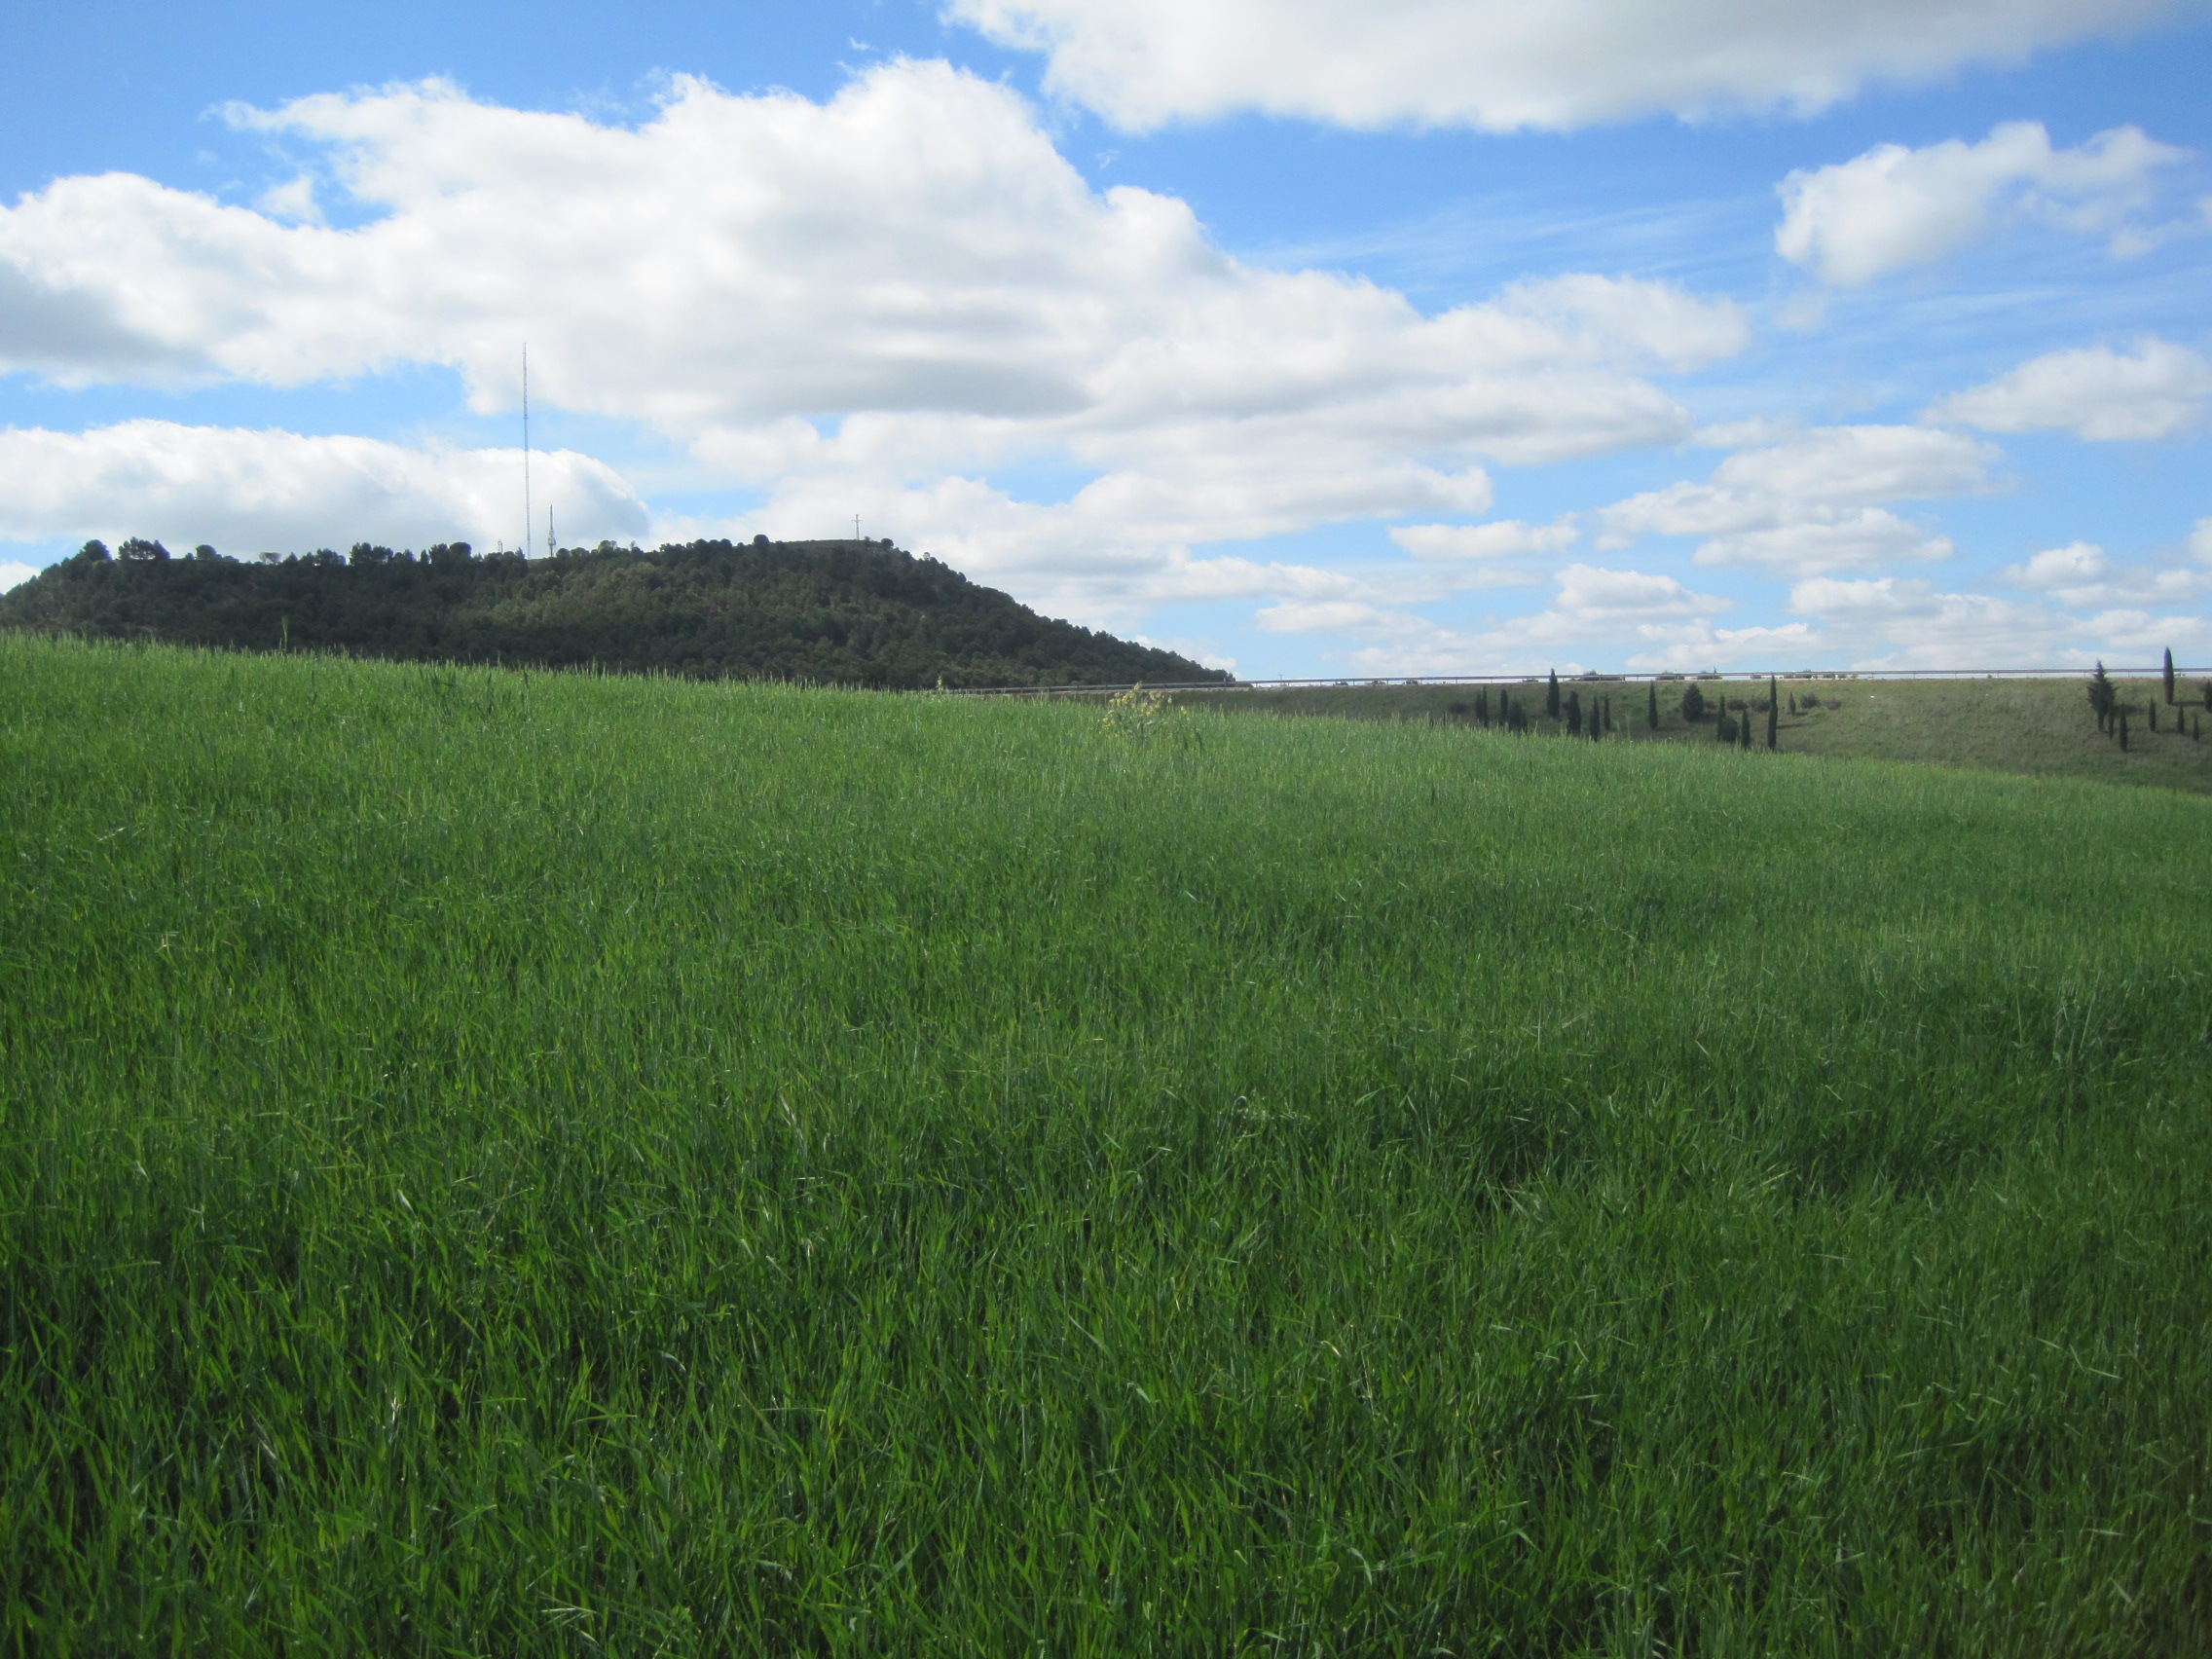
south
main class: Cropland
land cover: Barley
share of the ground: > 75 %
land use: Agriculture (excluding fallow land and kitchen gardens)
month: May
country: ES
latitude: 41.6155
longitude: -4.6727
